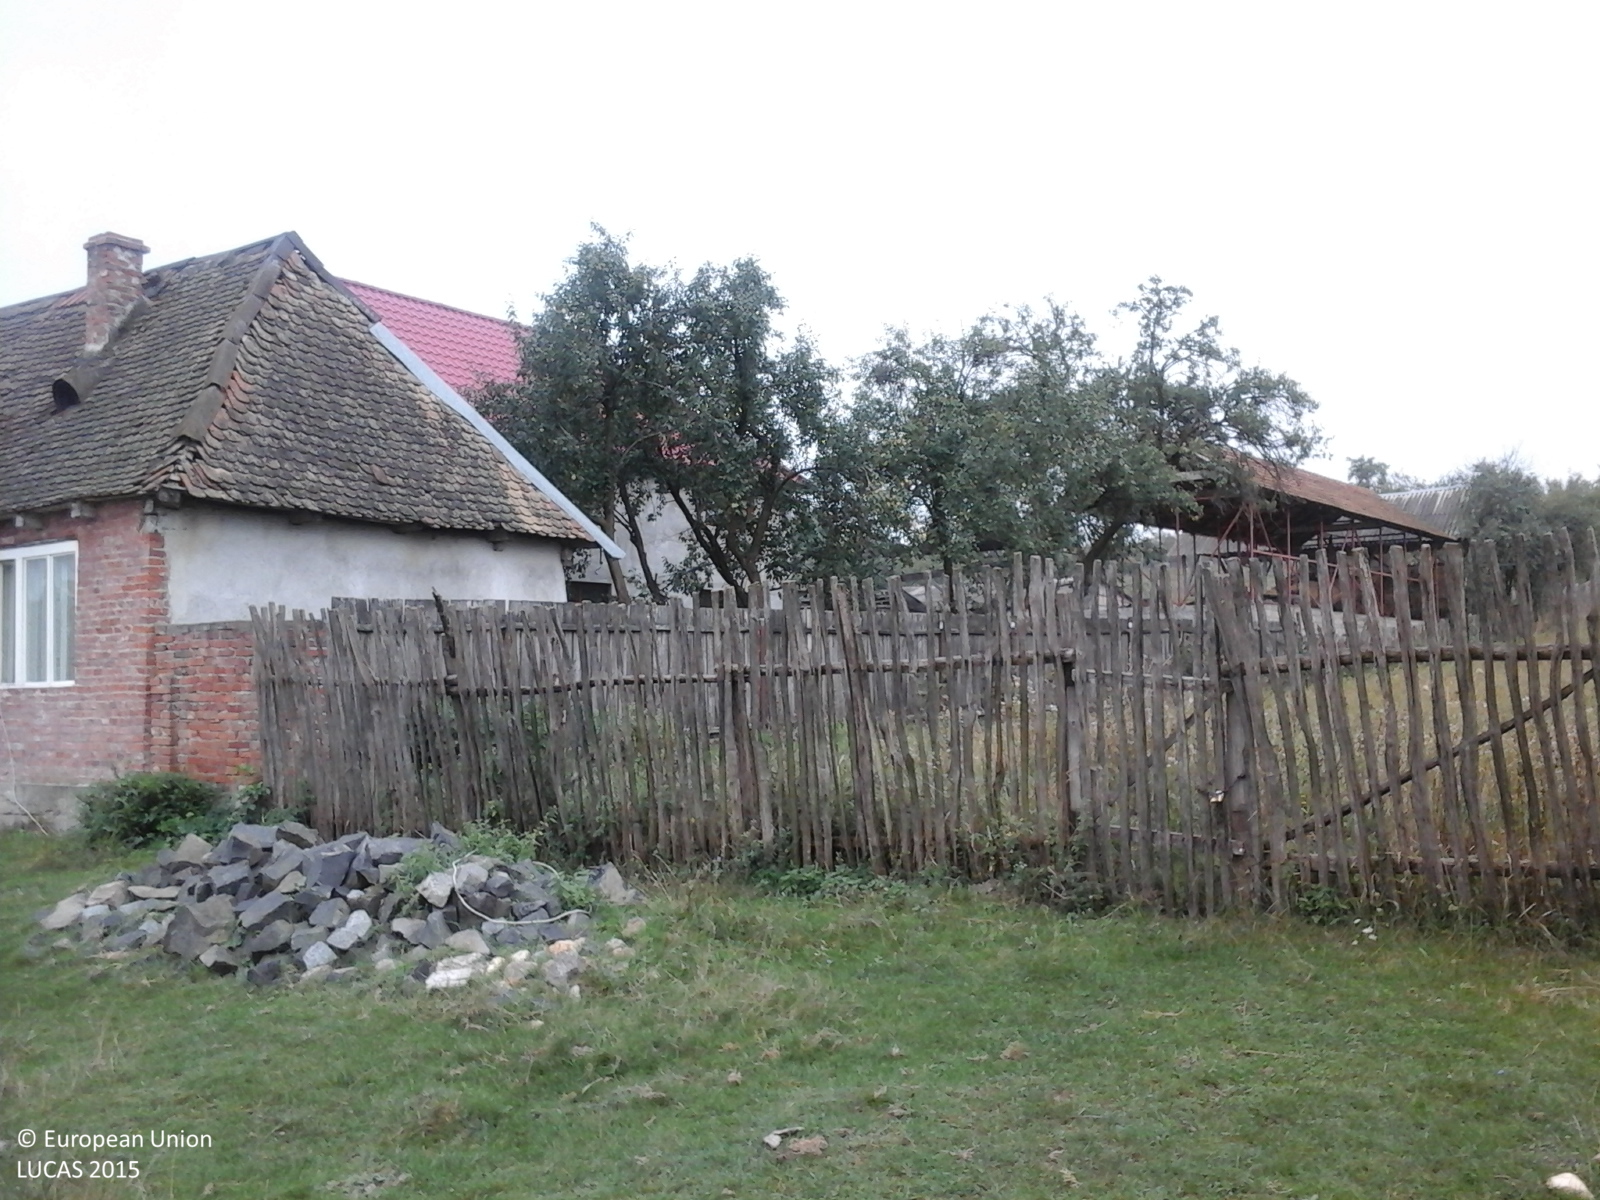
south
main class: Cropland
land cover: Apple fruit
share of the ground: > 75 %
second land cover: Grassland without tree/shrub cover
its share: > 75 %
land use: Agriculture (excluding fallow land and kitchen gardens)
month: September
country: RO
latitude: 45.6058
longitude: 21.9498
